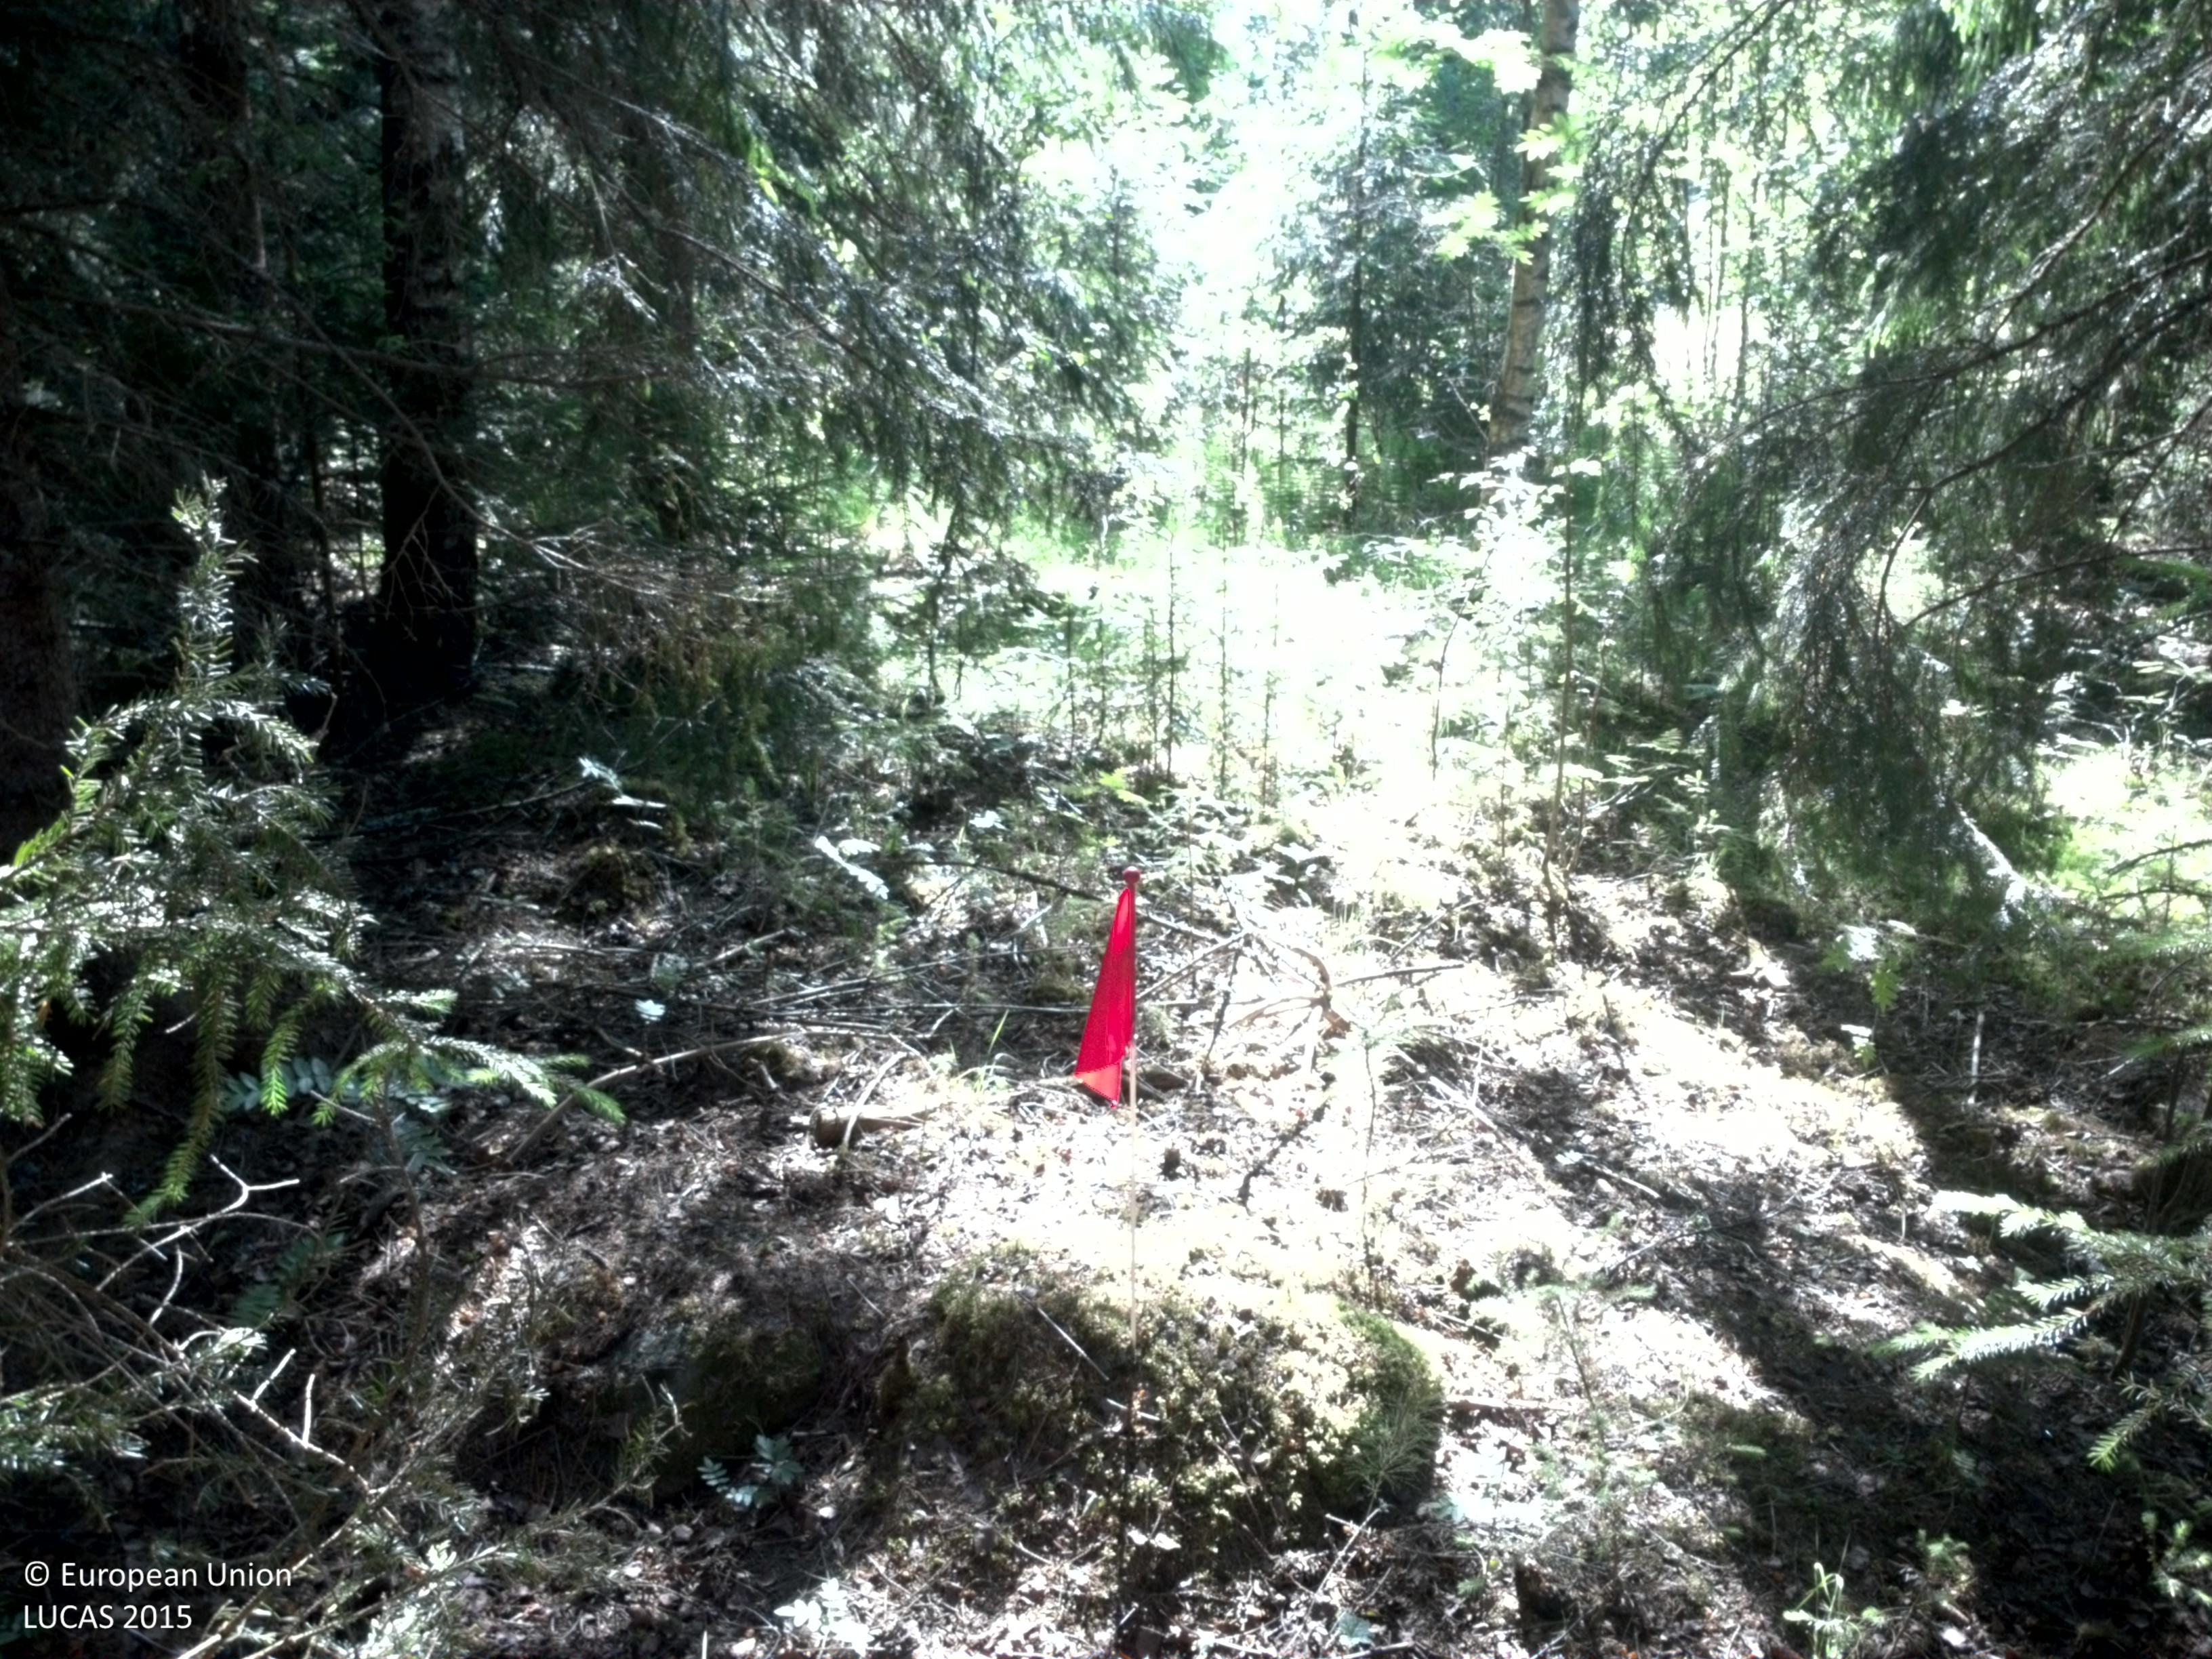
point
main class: Woodland
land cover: Spruce dominated mixed woodland
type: boreal forest
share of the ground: 50 - 75 %
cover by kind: coniferous forest trees 45 %, herbaceous plants 20 %, broadleaved forest trees 15 %, shrubs 10 %, lichens and mosses 10 %
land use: Forestry
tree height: > 5 m
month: July
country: SE
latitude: 59.9271
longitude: 12.3371
